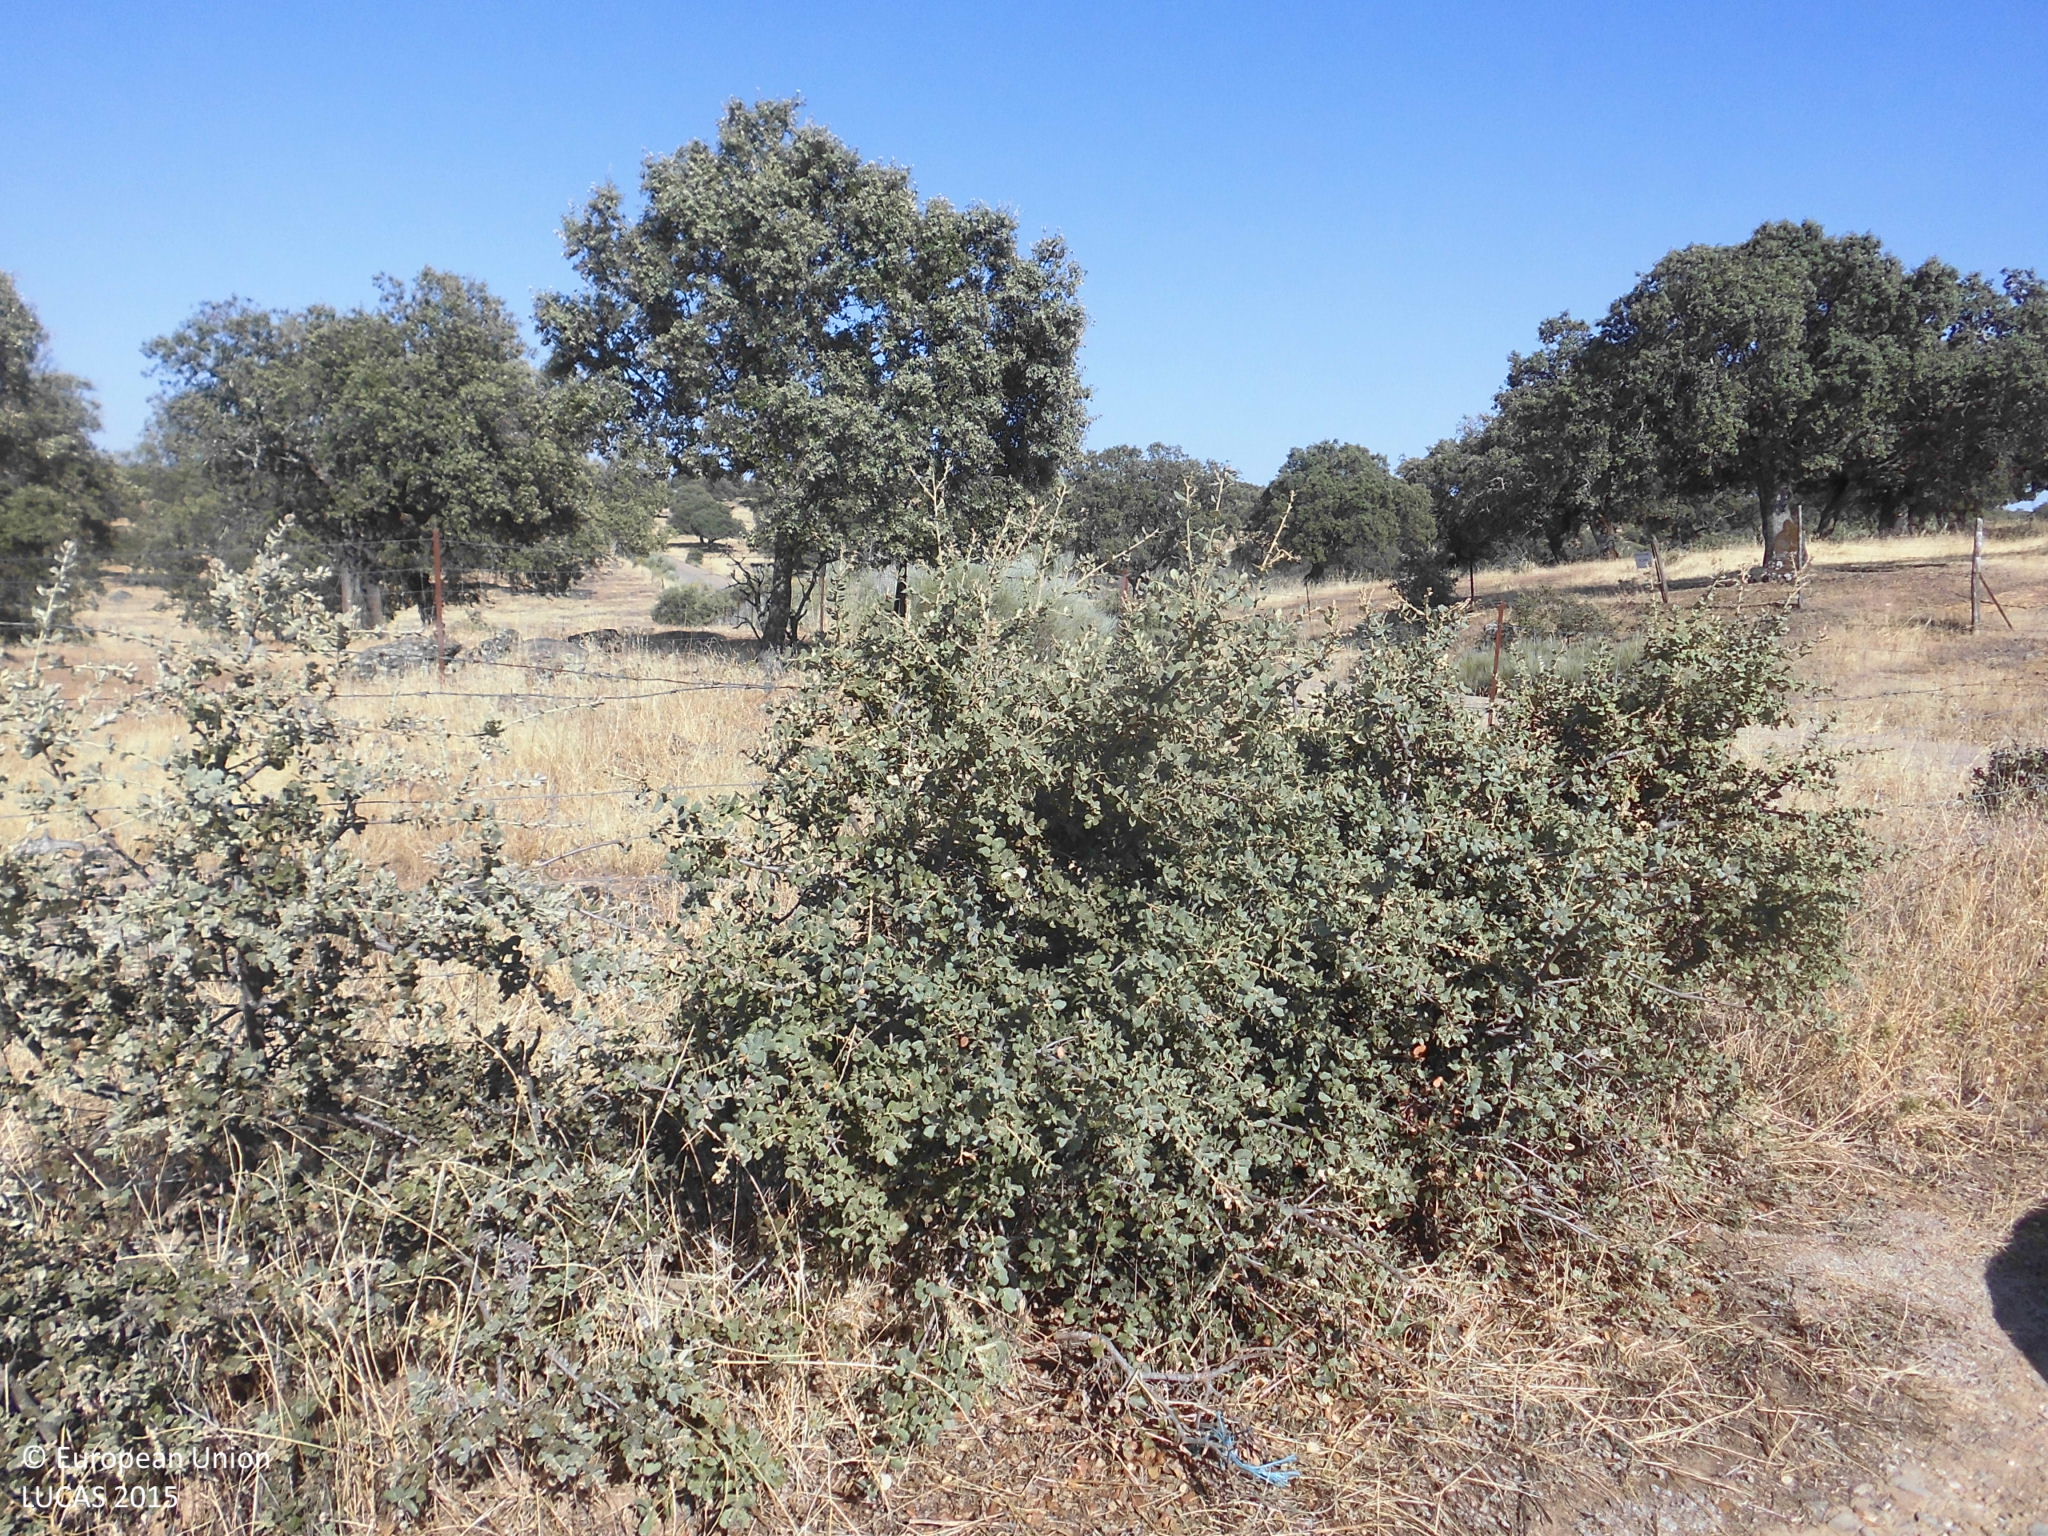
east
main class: Woodland
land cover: Broadleaved woodland
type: broadleaved evergreen forest
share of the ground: 10 - 25 %
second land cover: Grassland without tree/shrub cover
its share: > 75 %
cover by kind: herbaceous plants 80 %, broadleaved forest trees 20 %
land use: Forestry
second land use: Agriculture (excluding fallow land and kitchen gardens)
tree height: > 5 m
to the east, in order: Broadleaved woodland; Grassland without tree/shrub cover; Broadleaved woodland; Rivers and streams; Broadleaved woodland
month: July
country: ES
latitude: 39.5636
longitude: -5.5934
